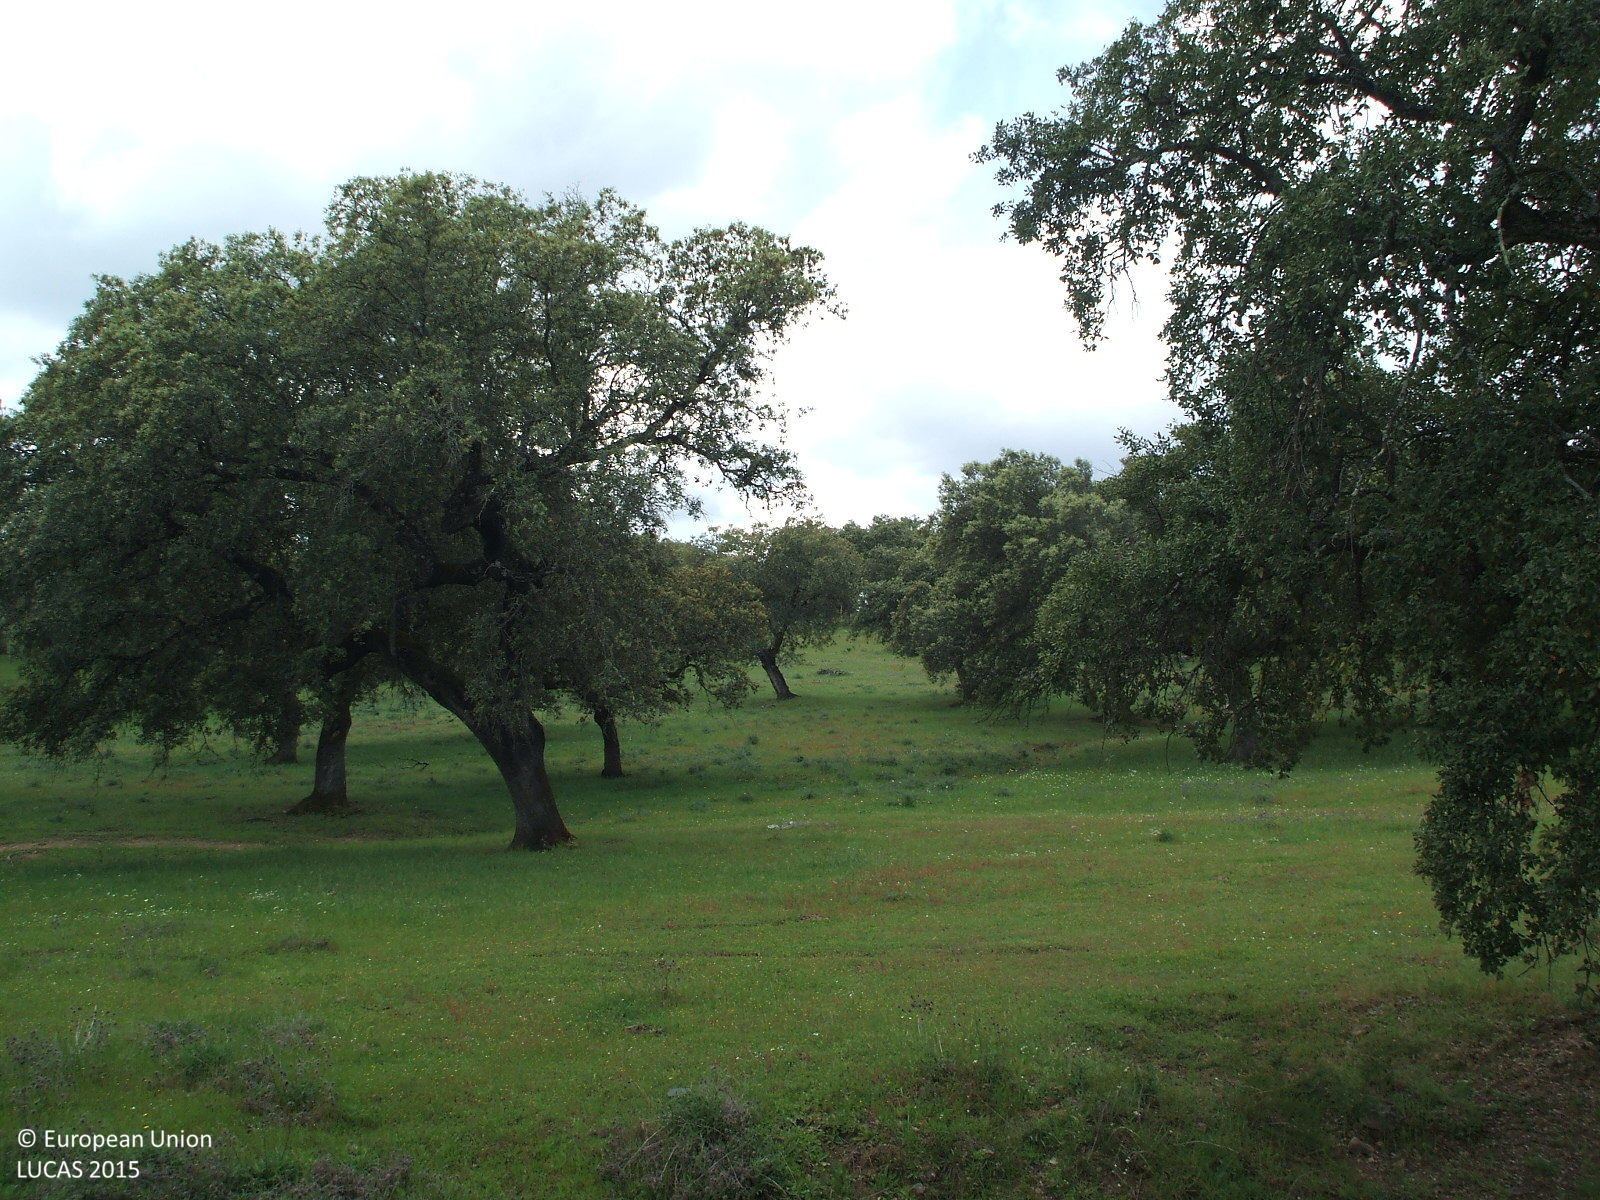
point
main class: Woodland
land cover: Broadleaved woodland
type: broadleaved evergreen forest
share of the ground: 25 - 50 %
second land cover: Grassland without tree/shrub cover
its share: > 75 %
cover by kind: herbaceous plants 70 %, broadleaved forest trees 30 %
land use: Forestry
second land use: Agriculture (excluding fallow land and kitchen gardens)
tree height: > 5 m
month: April
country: ES
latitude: 37.9513
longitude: -6.2095
